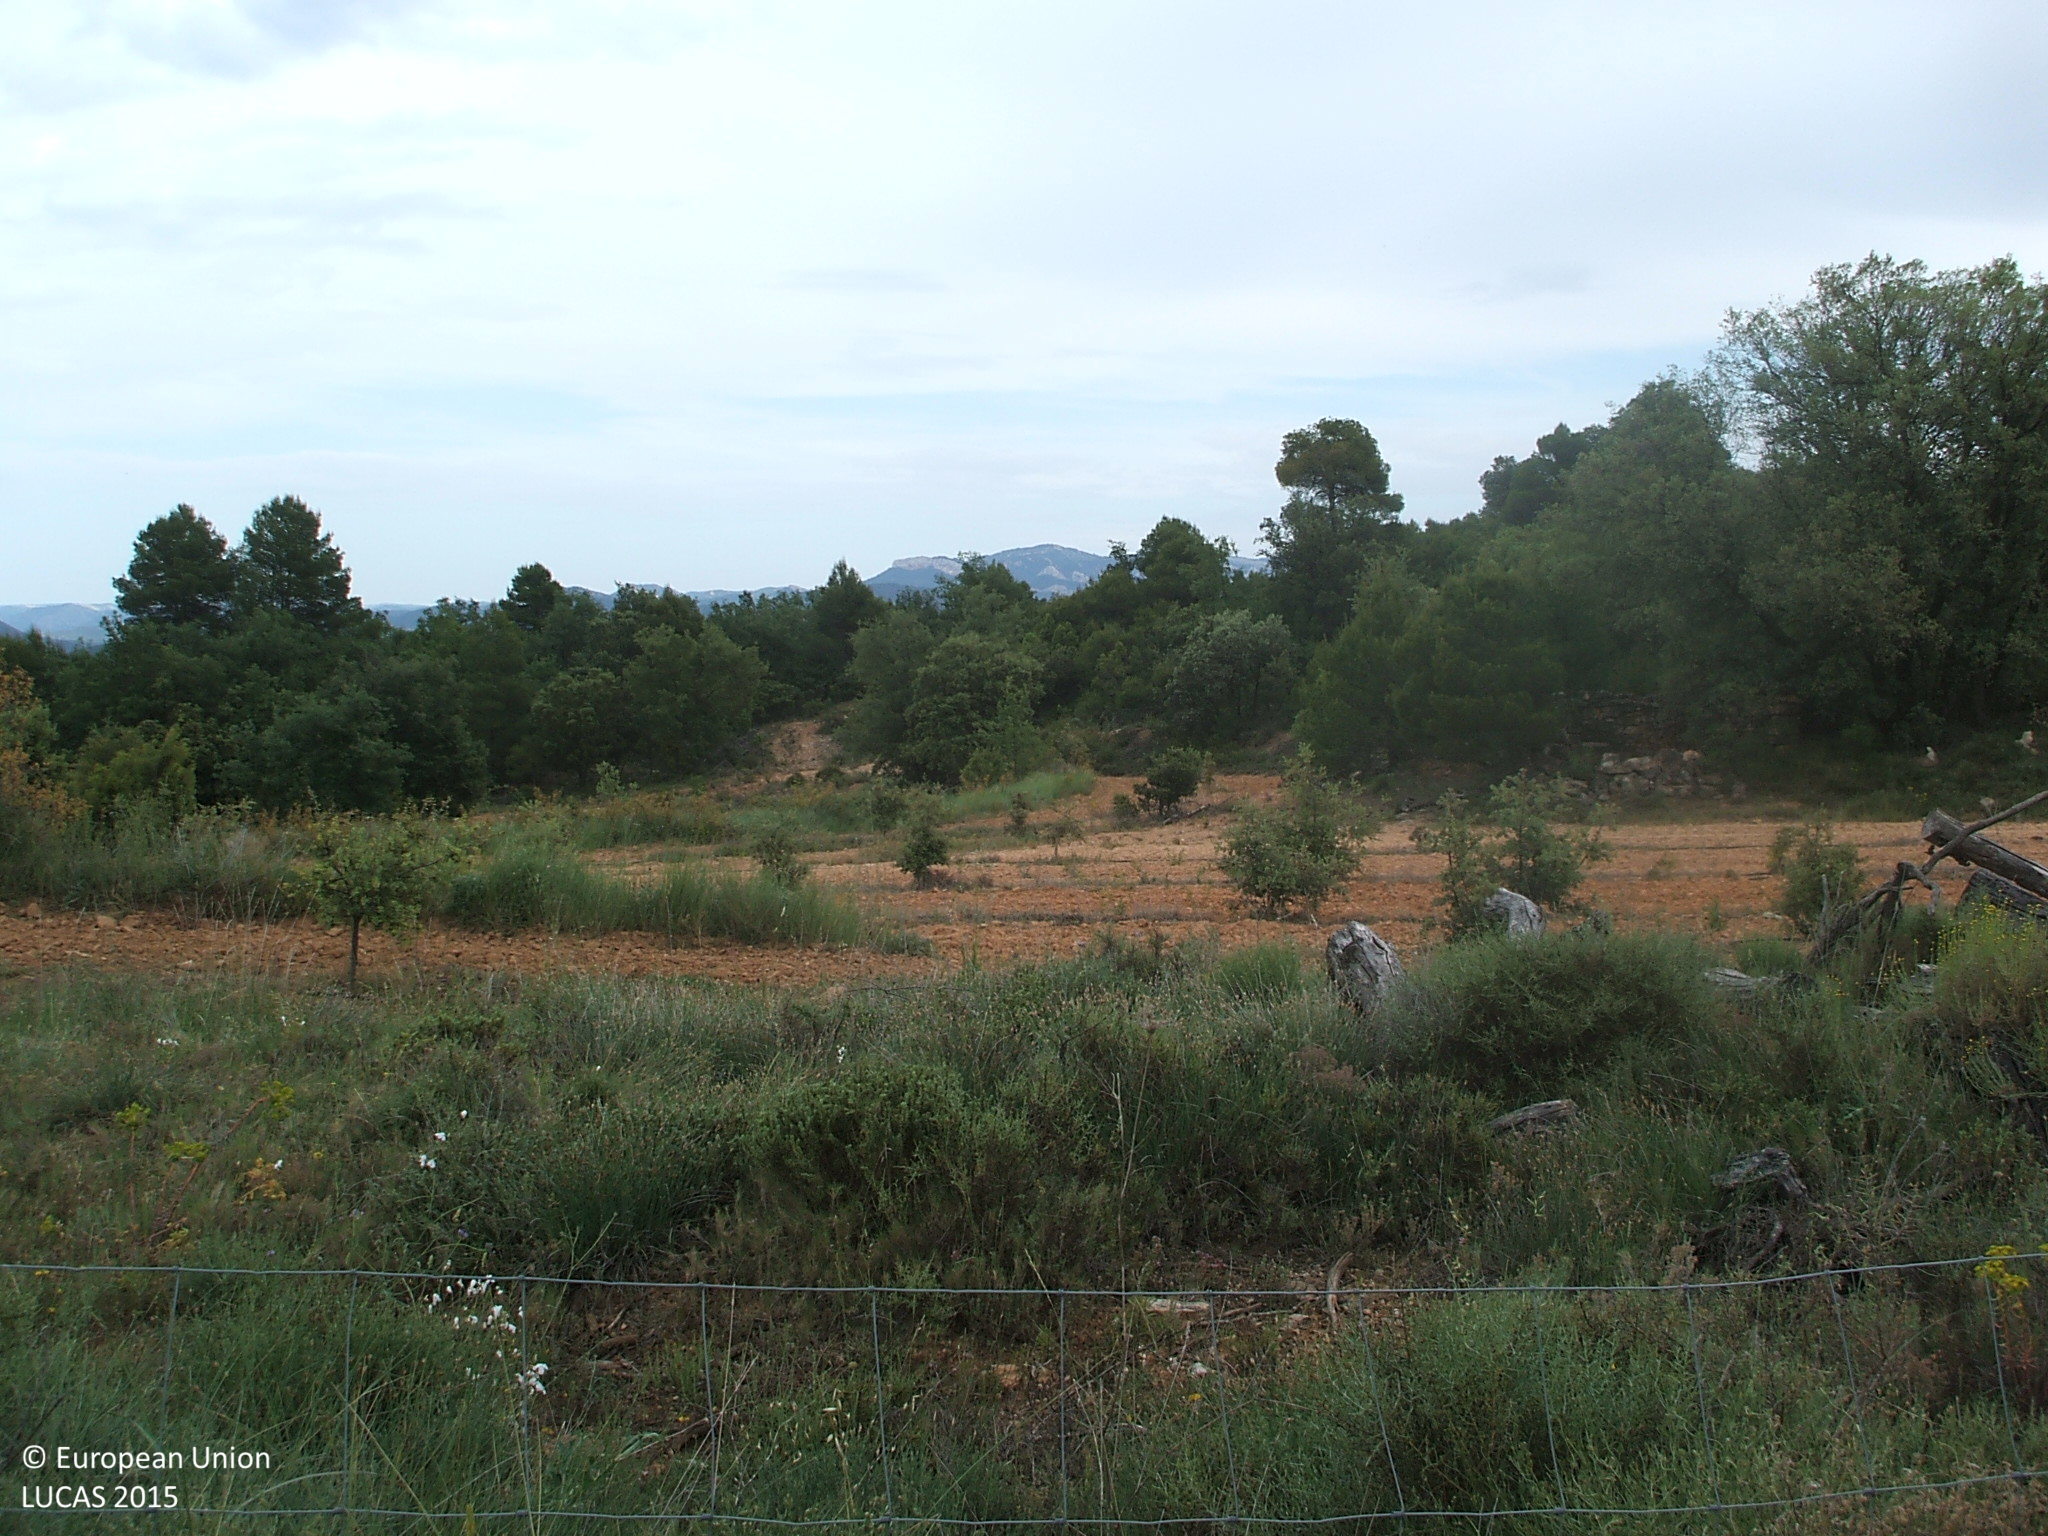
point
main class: Cropland
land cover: Other fresh vegetables
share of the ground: 10 - 25 %
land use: Agriculture (excluding fallow land and kitchen gardens)
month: June
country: ES
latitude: 40.7731
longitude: -0.0198
